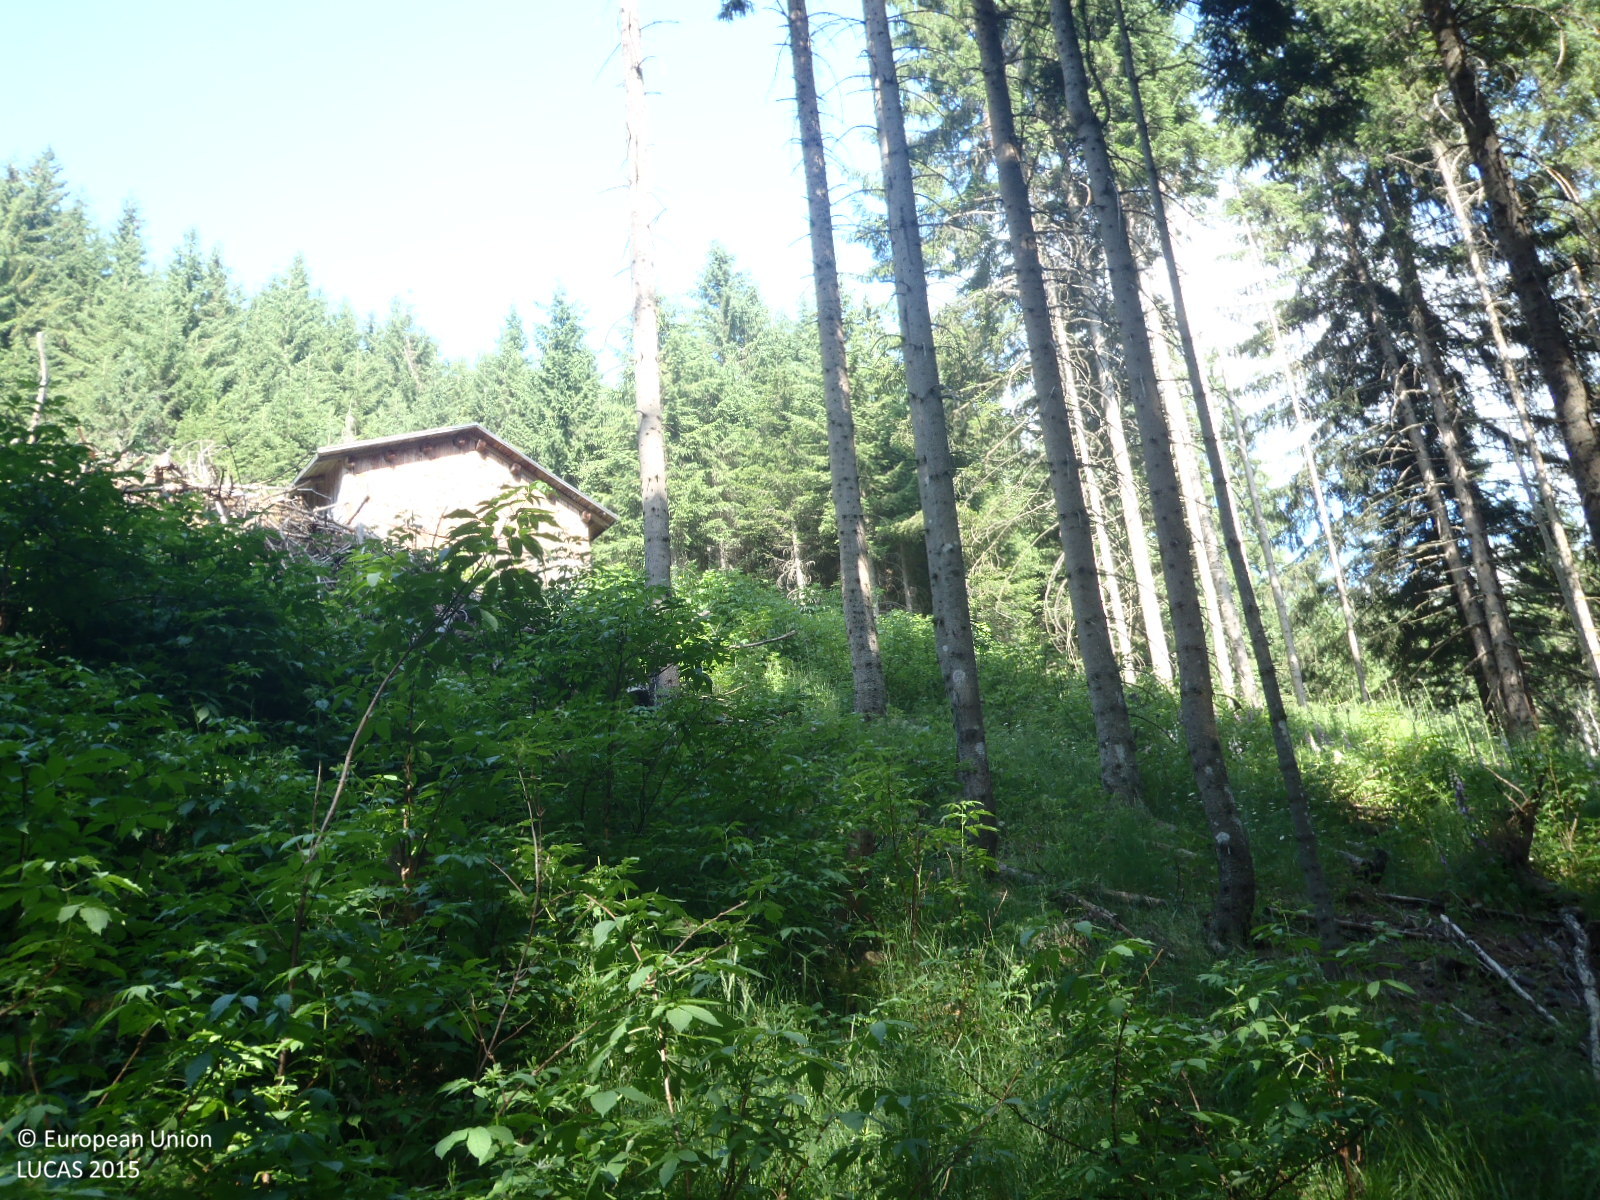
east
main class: Woodland
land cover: Spruce dominated coniferous woodland
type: alpine coniferous forest
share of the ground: > 75 %
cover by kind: coniferous forest trees 100 %
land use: Forestry
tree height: > 5 m
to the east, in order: Spruce dominated coniferous woodland; Shrubland without tree cover; Grass margins; Tracks; Grassland without tree/shrub cover; Spruce dominated coniferous woodland; Tracks; Spruce dominated coniferous woodland; Shruby margins; Tracks; Grassland with sparse tree/shrub cover; Spruce dominated coniferous woodland; Tracks; Spruce dominated coniferous woodland
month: July
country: AT
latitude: 47.0895
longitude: 10.0132
